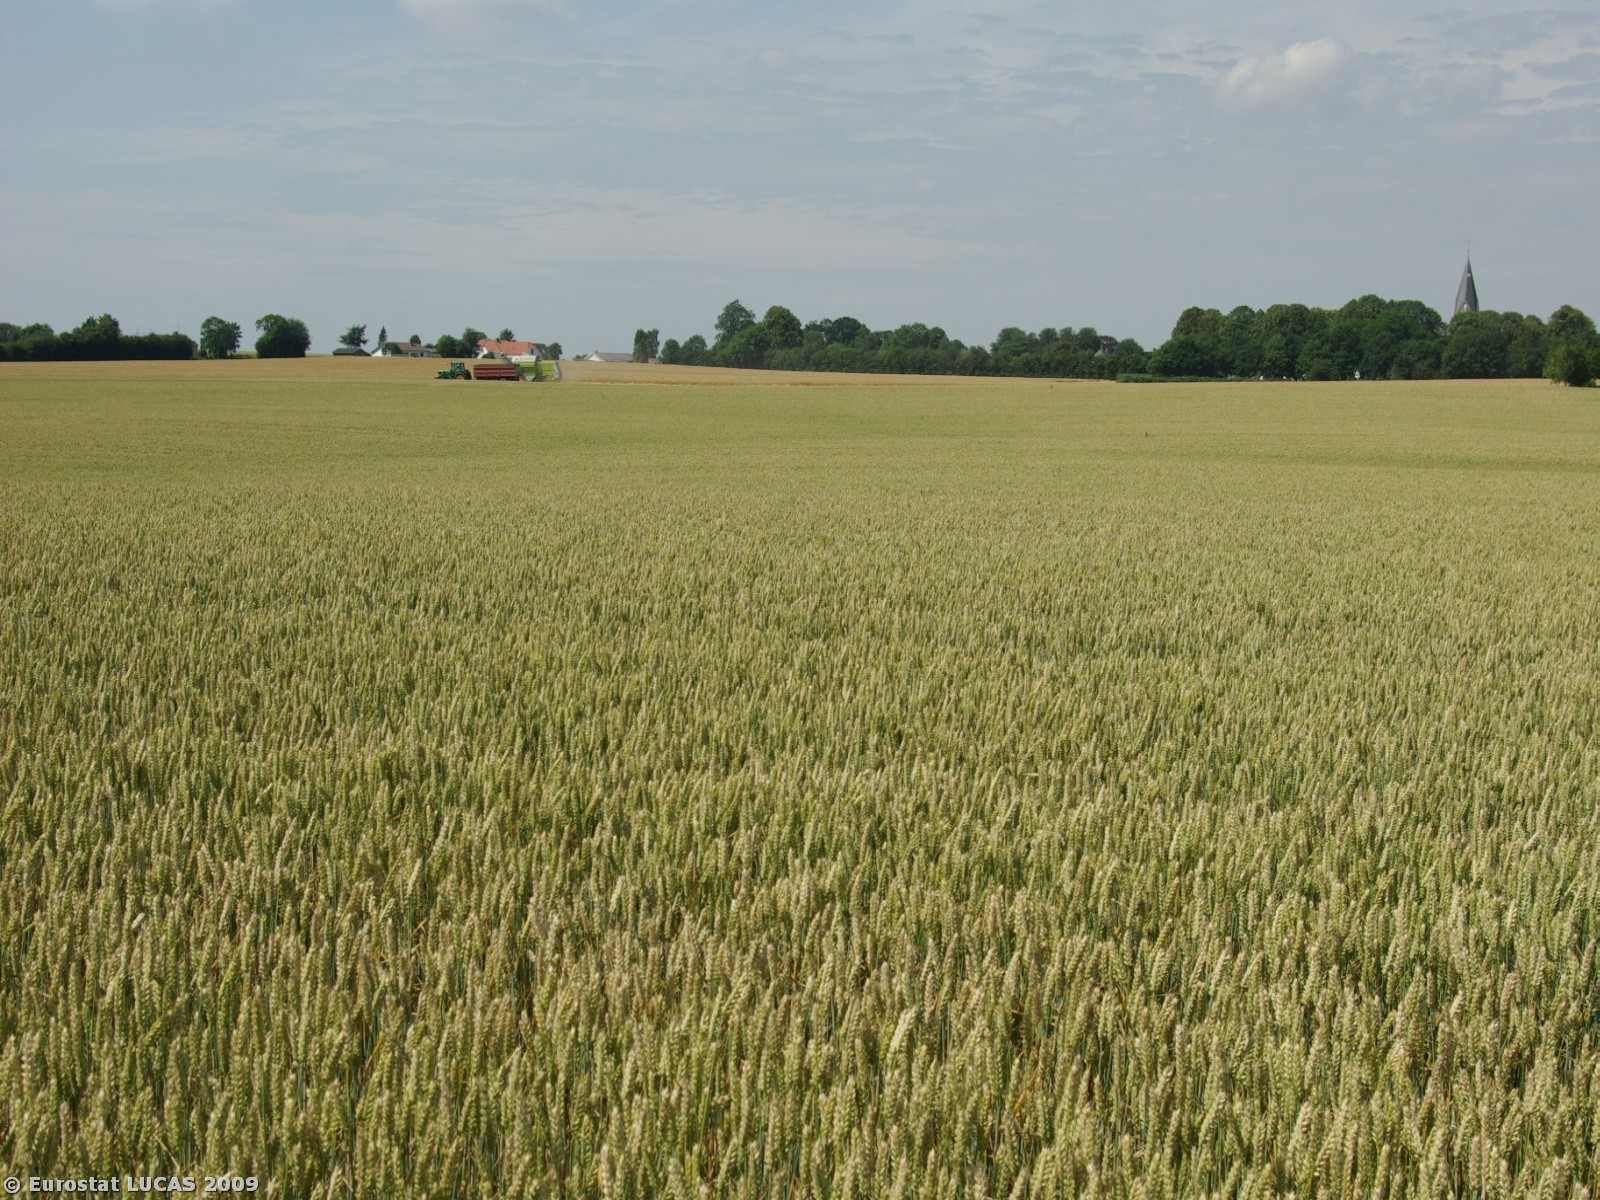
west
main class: Cropland
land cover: Common wheat
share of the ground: > 75 %
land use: Agriculture (excluding fallow land and kitchen gardens)
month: July
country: DK
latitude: 54.9651
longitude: 9.6723
